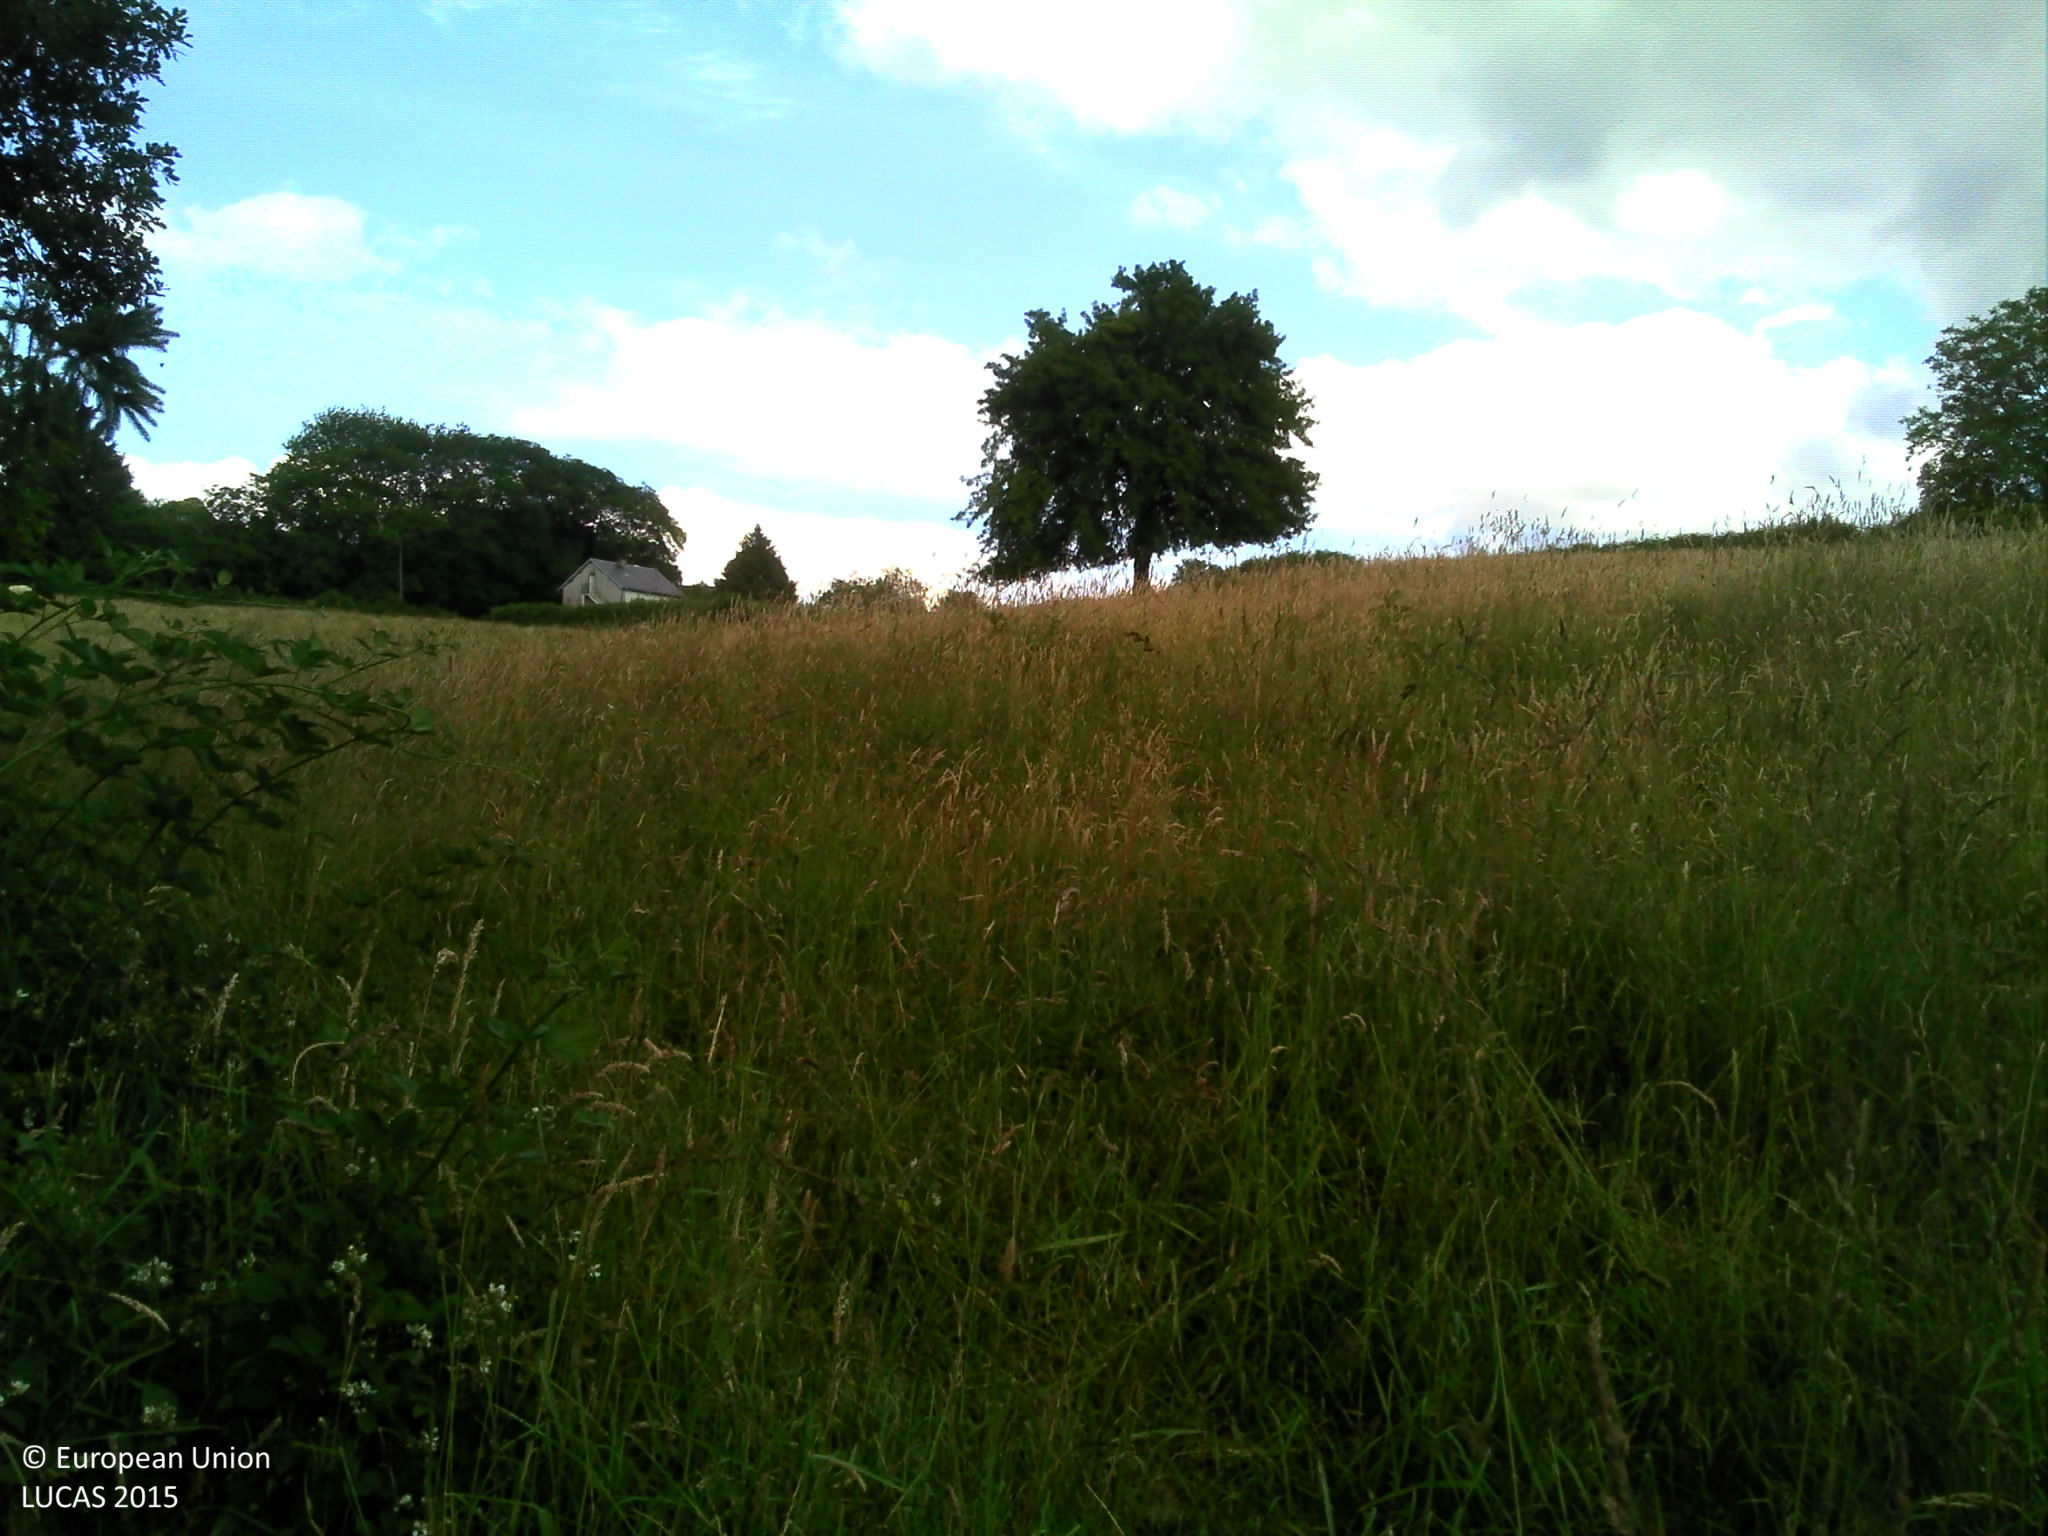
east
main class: Grassland
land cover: Grassland without tree/shrub cover
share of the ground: > 75 %
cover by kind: herbaceous plants 100 %
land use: Agriculture (excluding fallow land and kitchen gardens)
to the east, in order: Grassland without tree/shrub cover; Fences; Managed hedges; Fences; Grassland with sparse tree/shrub cover; Fences; Managed hedges; Ditches and canals; Grass margins; Electric lines; Paved roads, cycling and walking lanes; Grass margins
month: June
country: FR
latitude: 47.2293
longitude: 3.9889
